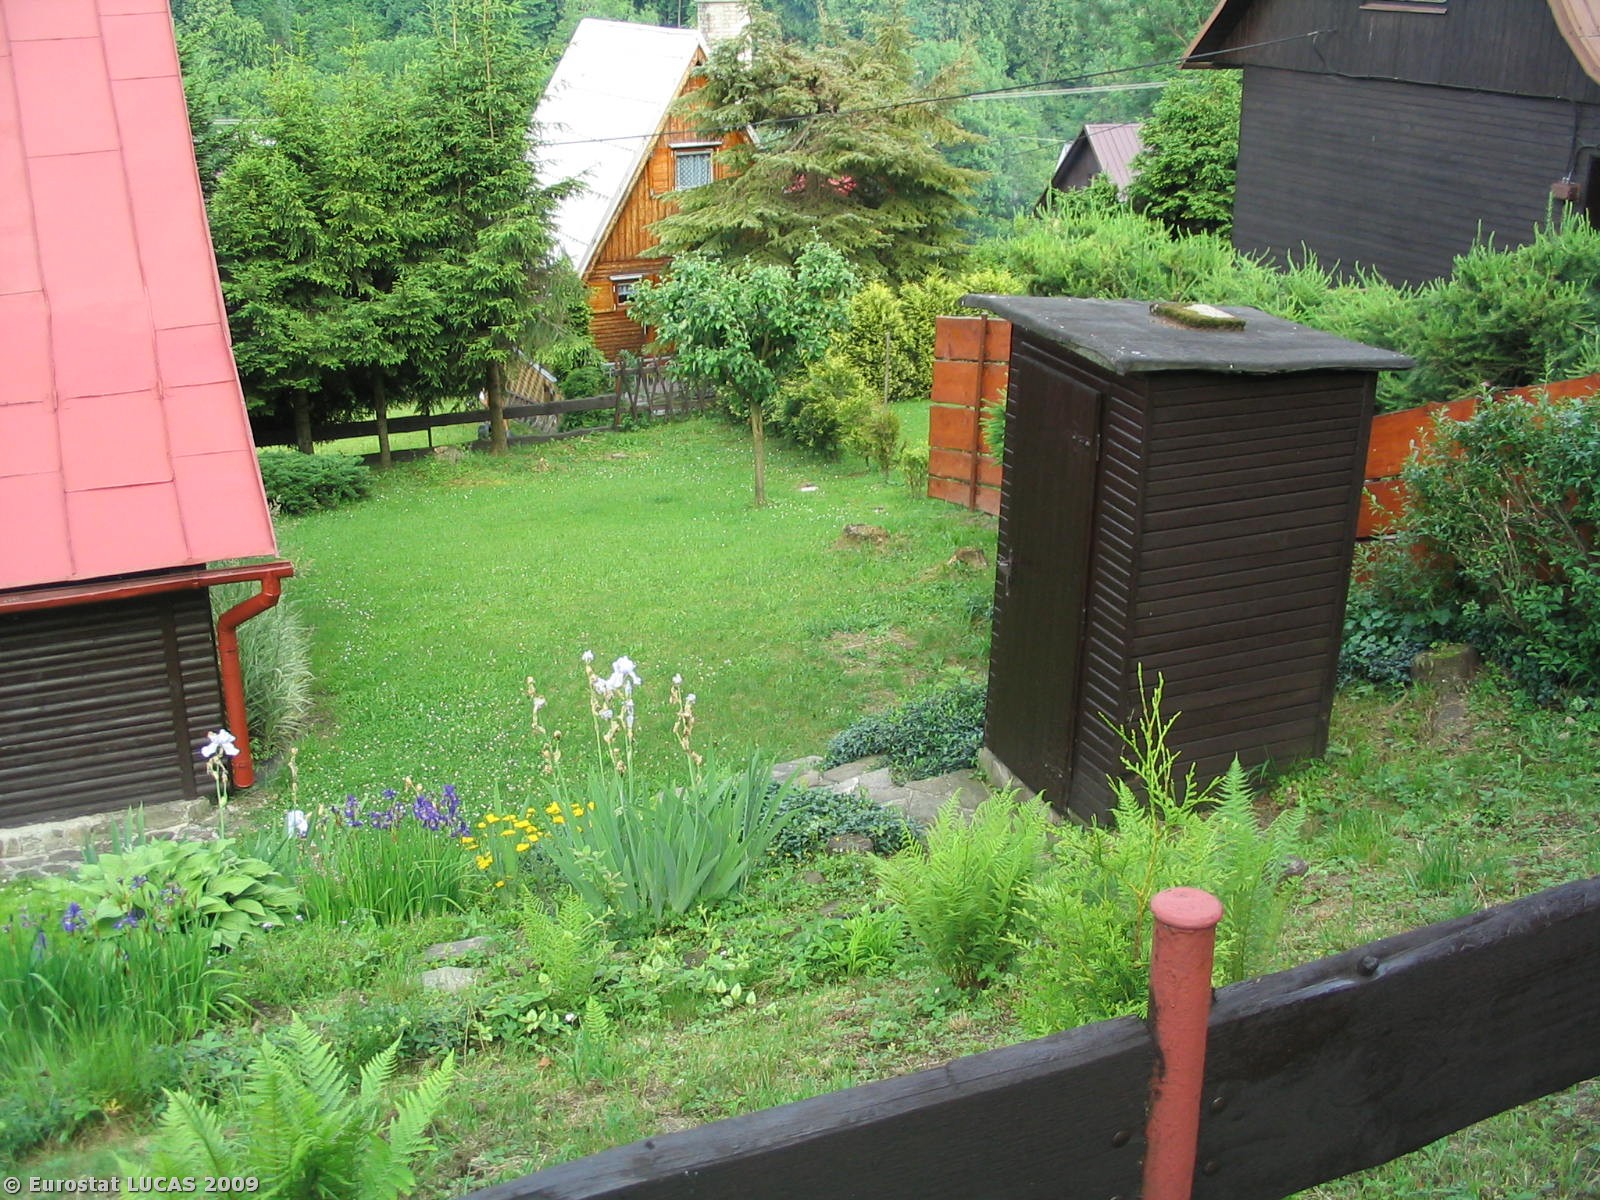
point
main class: Grassland
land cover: Grassland without tree/shrub cover
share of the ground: > 75 %
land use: Residential
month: June
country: CZ
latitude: 49.6654
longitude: 18.7630
